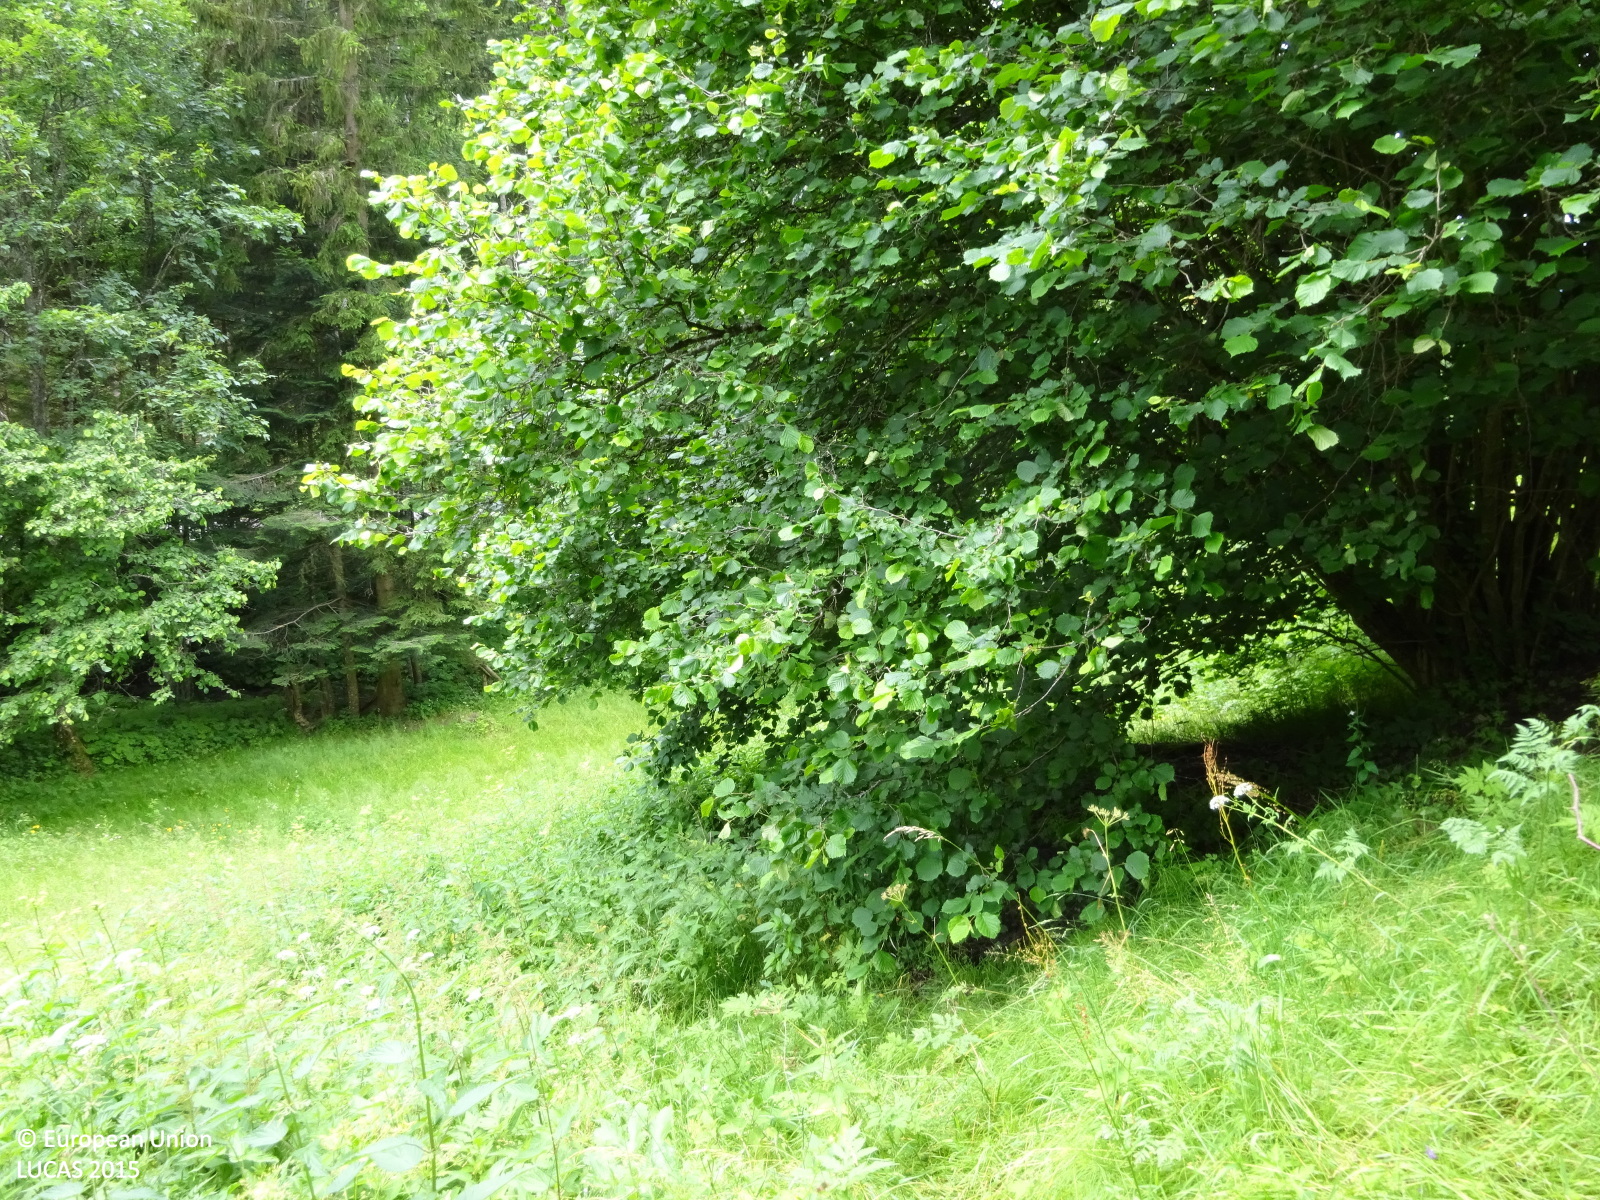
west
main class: Grassland
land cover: Grassland without tree/shrub cover
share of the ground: > 75 %
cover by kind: herbaceous plants 100 %
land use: Agriculture (excluding fallow land and kitchen gardens)
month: June
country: AT
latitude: 47.5887
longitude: 15.7063
